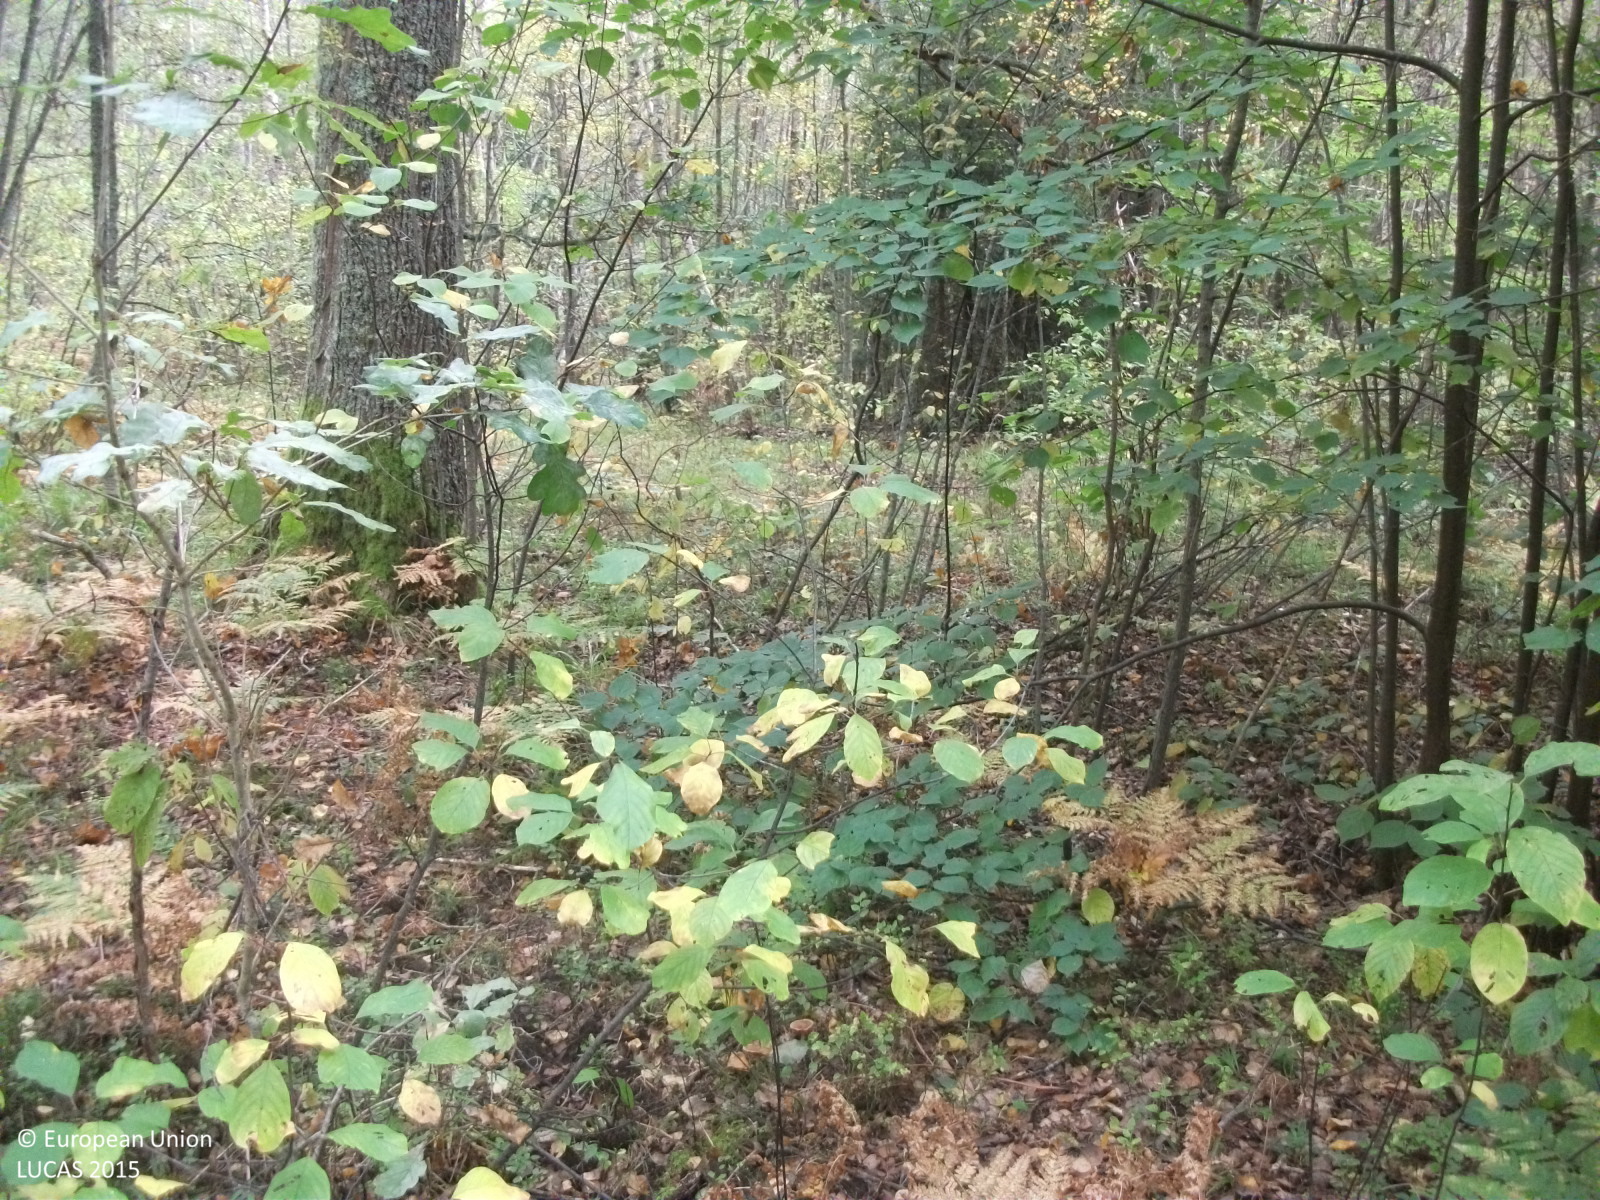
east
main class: Woodland
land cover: Broadleaved woodland
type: non-riverine alder, birch or aspen forest
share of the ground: > 75 %
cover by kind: broadleaved forest trees 85 %, coniferous forest trees 5 %, shrubs 5 %, herbaceous plants 5 %
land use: Forestry
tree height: > 5 m
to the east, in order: Broadleaved woodland; Pine dominated mixed woodland; Other mixed woodland; Broadleaved woodland; Pine dominated mixed woodland; Other mixed woodland
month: September
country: LV
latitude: 57.8667
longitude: 24.5014
